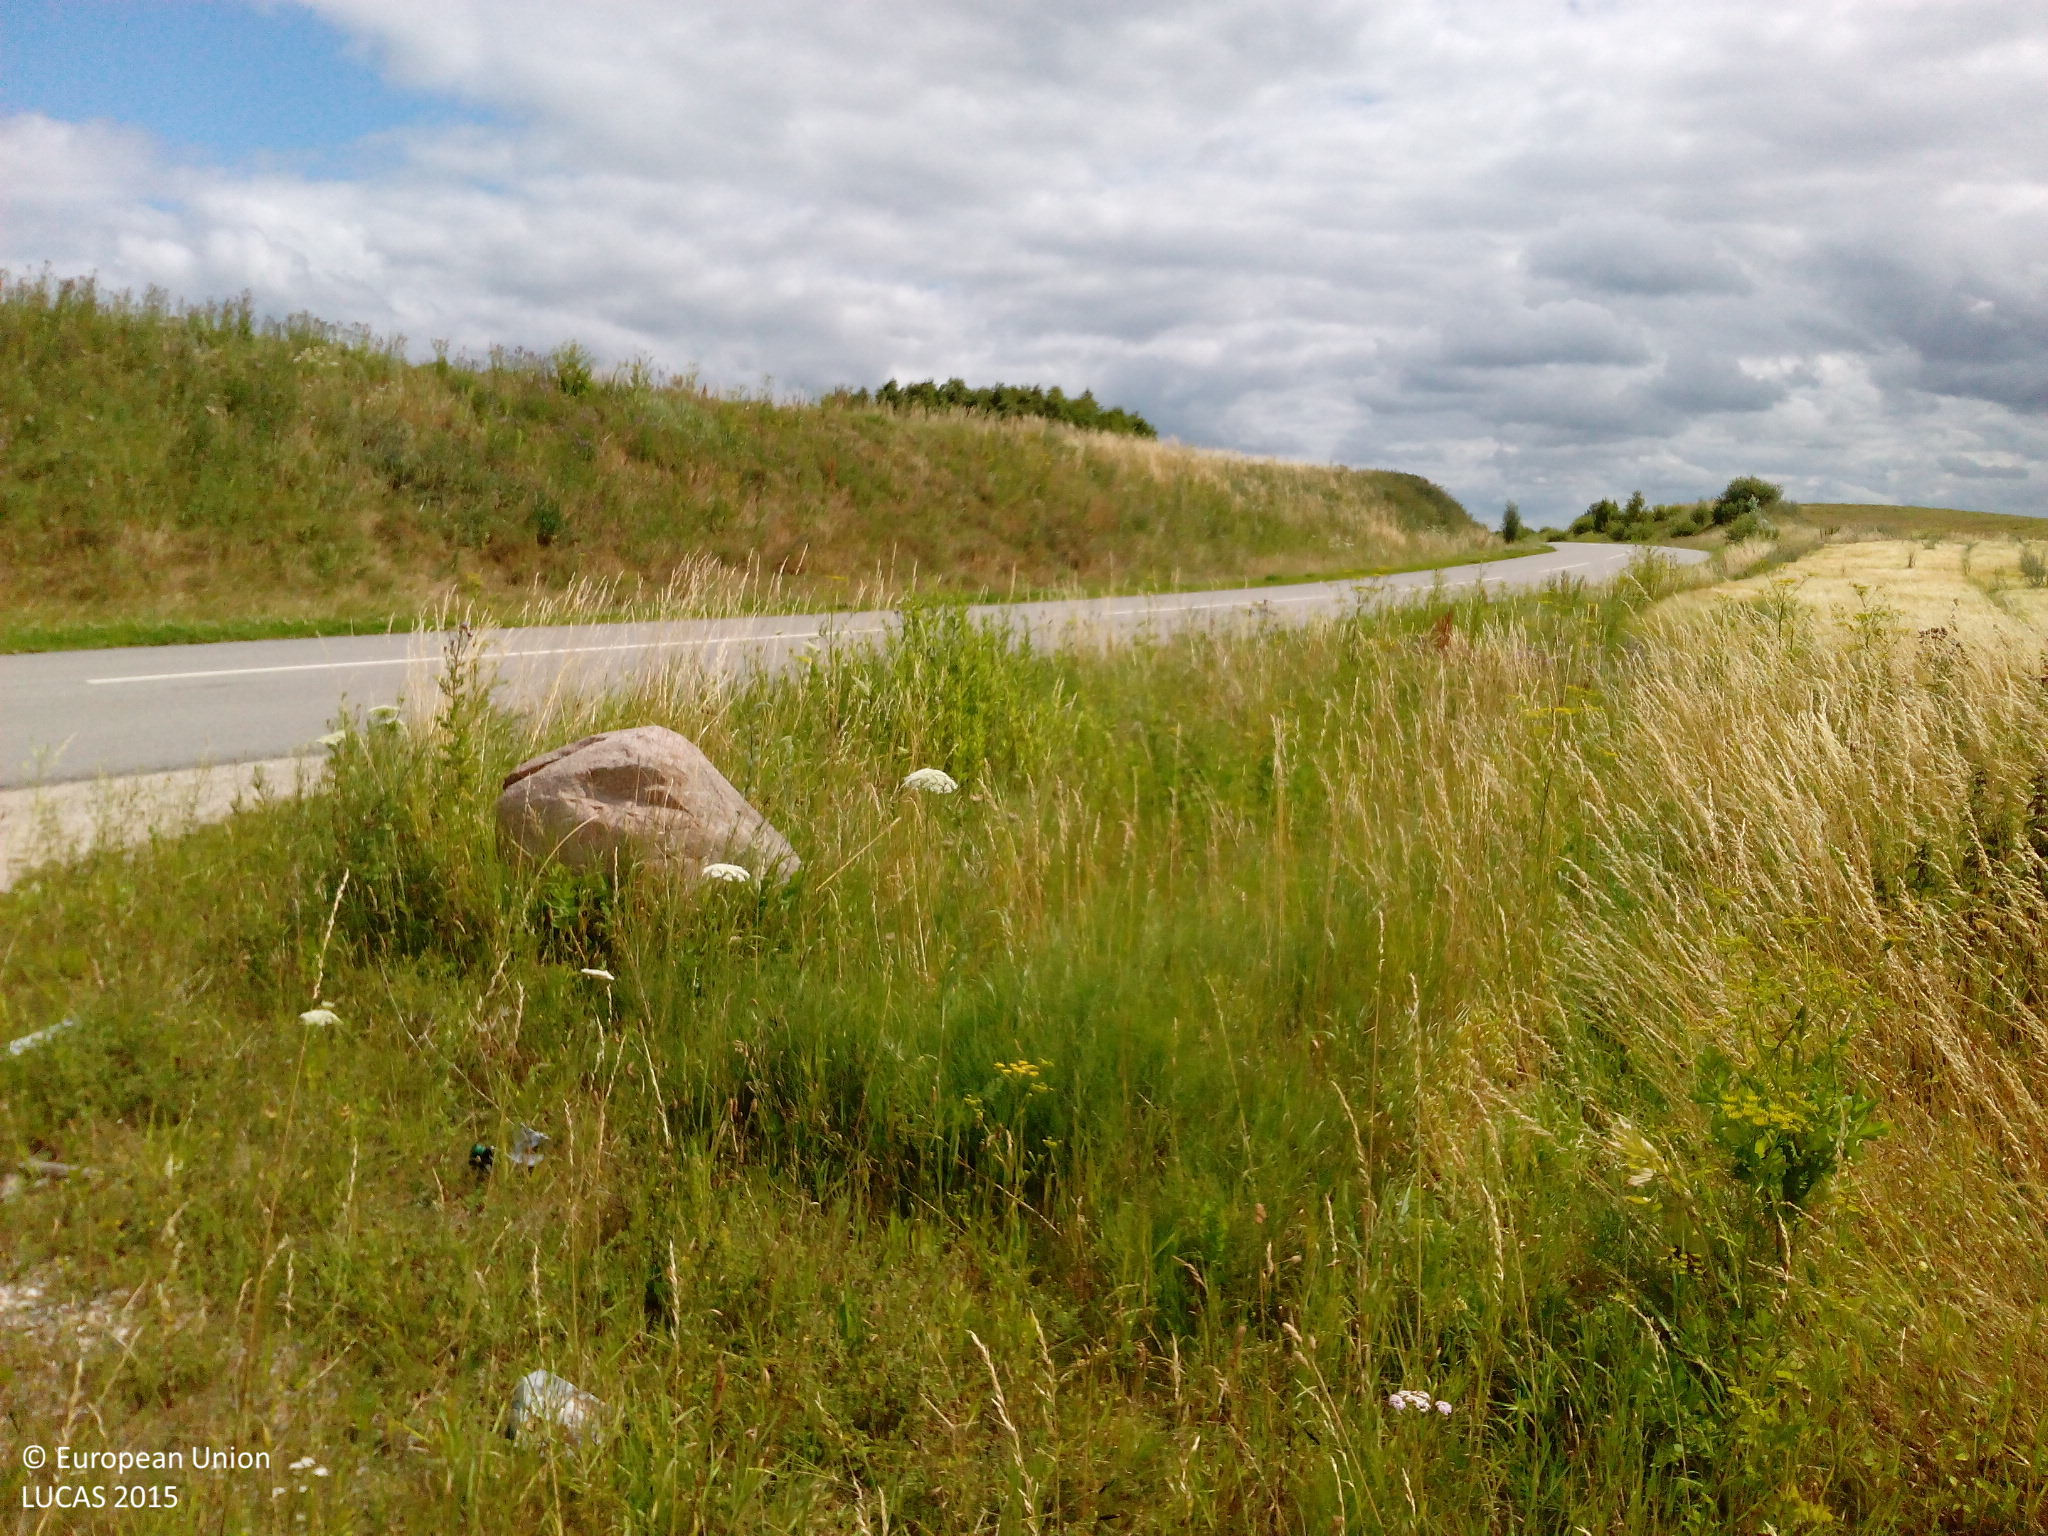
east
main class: Woodland
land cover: Broadleaved woodland
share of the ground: > 75 %
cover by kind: broadleaved forest trees 80 %, herbaceous plants 20 %
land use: Semi-natural and natural areas not in use
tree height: > 5 m
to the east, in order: Broadleaved woodland; Fences; Barley; Shruby margins; Dry pulses; Clovers; Shrubland without tree cover; Paved roads, cycling and walking lanes
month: July
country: DK
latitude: 55.9527
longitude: 12.2240
